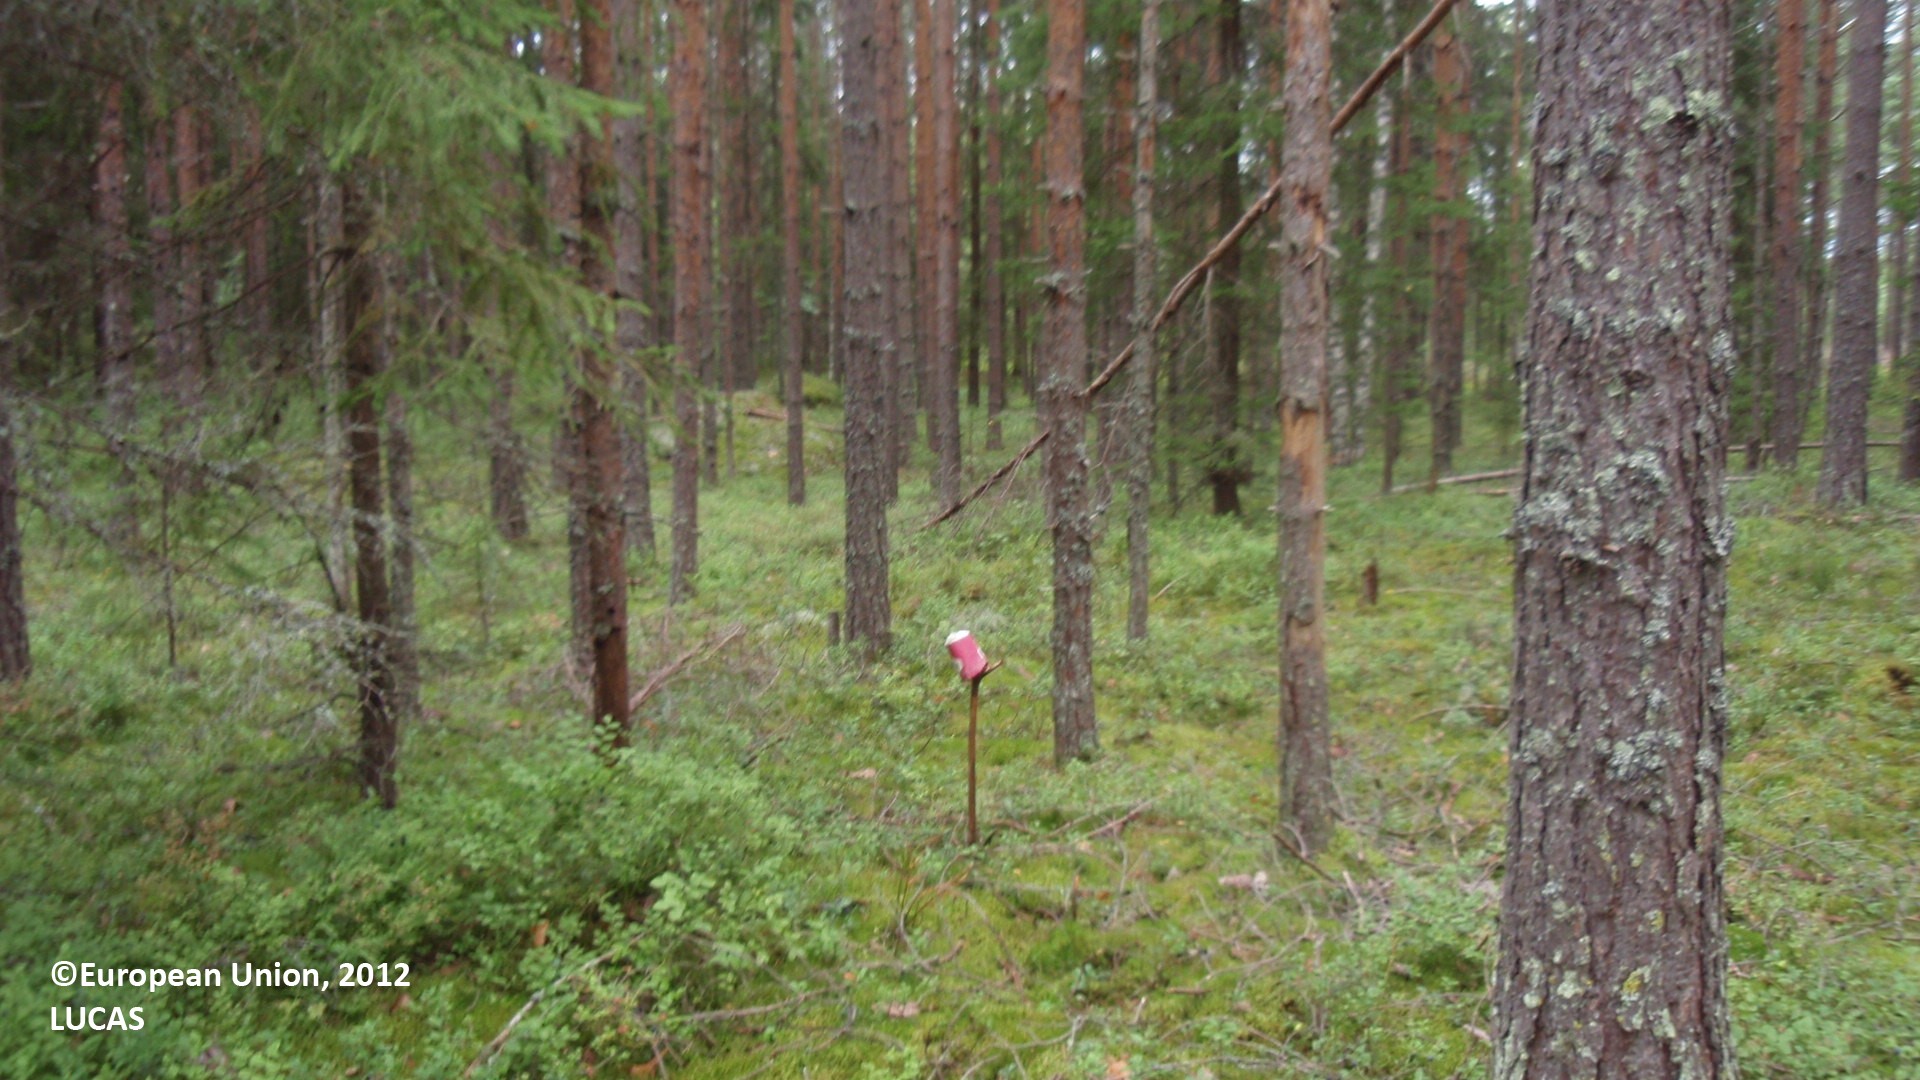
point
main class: Woodland
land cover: Pine dominated mixed woodland
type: boreal forest
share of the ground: 50 - 75 %
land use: Forestry
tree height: > 5 m
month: August
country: FI
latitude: 60.9331
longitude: 27.4334
